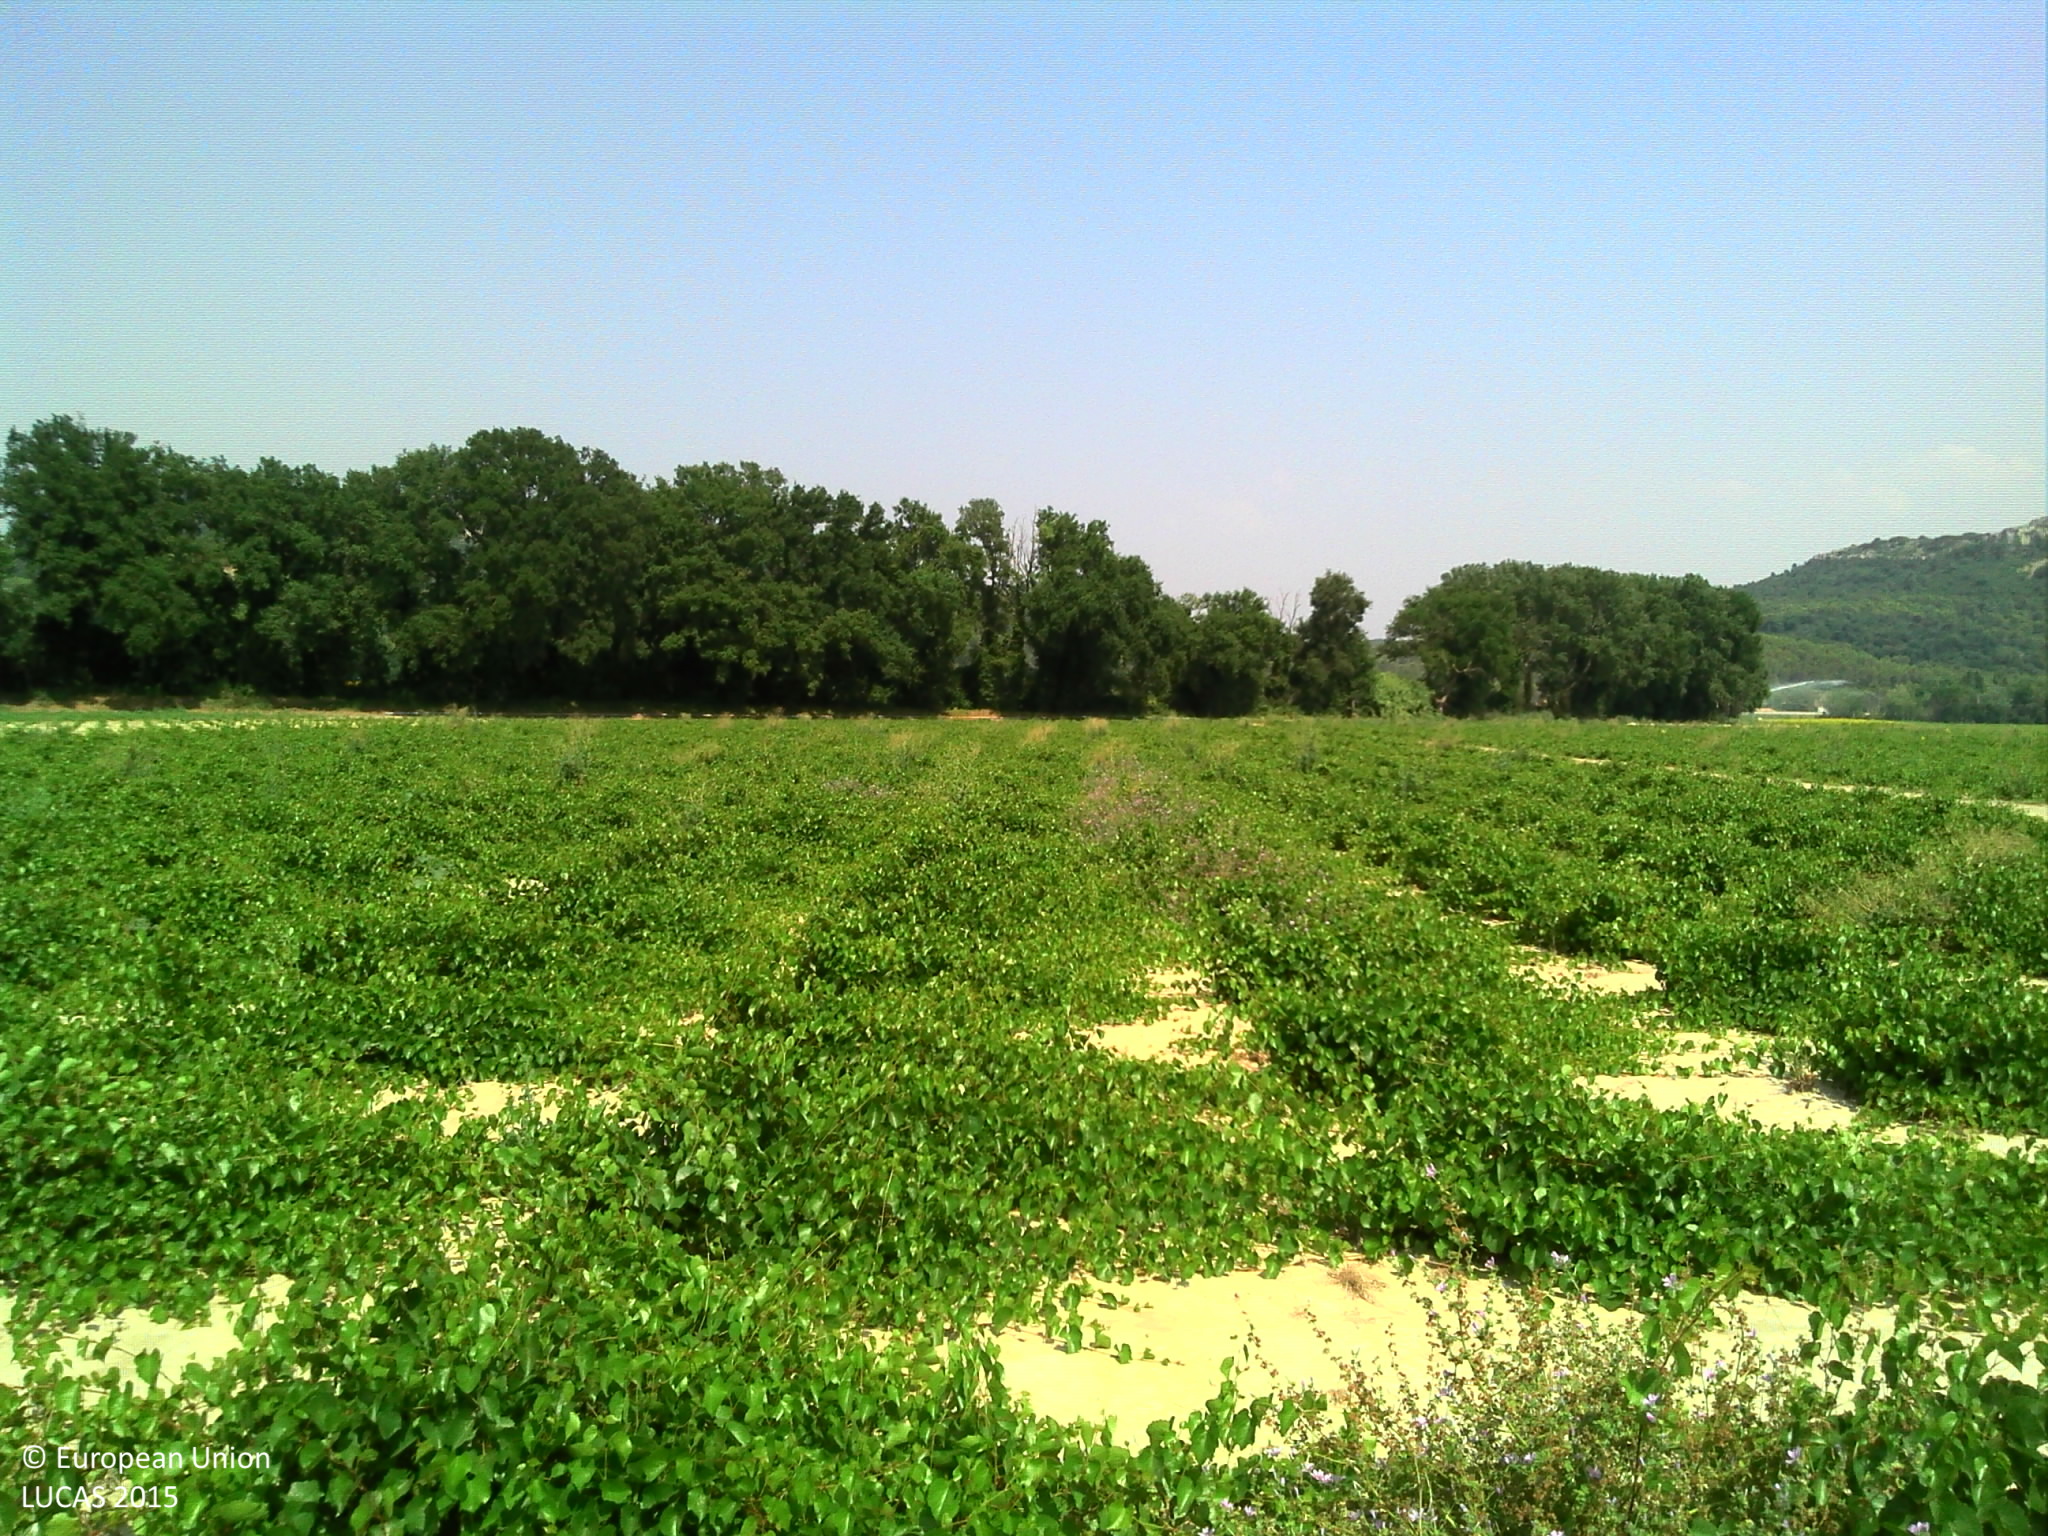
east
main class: Cropland
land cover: Nurseries
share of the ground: 50 - 75 %
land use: Agriculture (excluding fallow land and kitchen gardens)
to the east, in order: Nurseries; Tracks; Grass margins; Broadleaved woodland; Ditches and canals; Broadleaved woodland; Shruby margins; Tomatoes; Tracks; Tomatoes
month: July
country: FR
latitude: 44.2158
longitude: 4.7133
